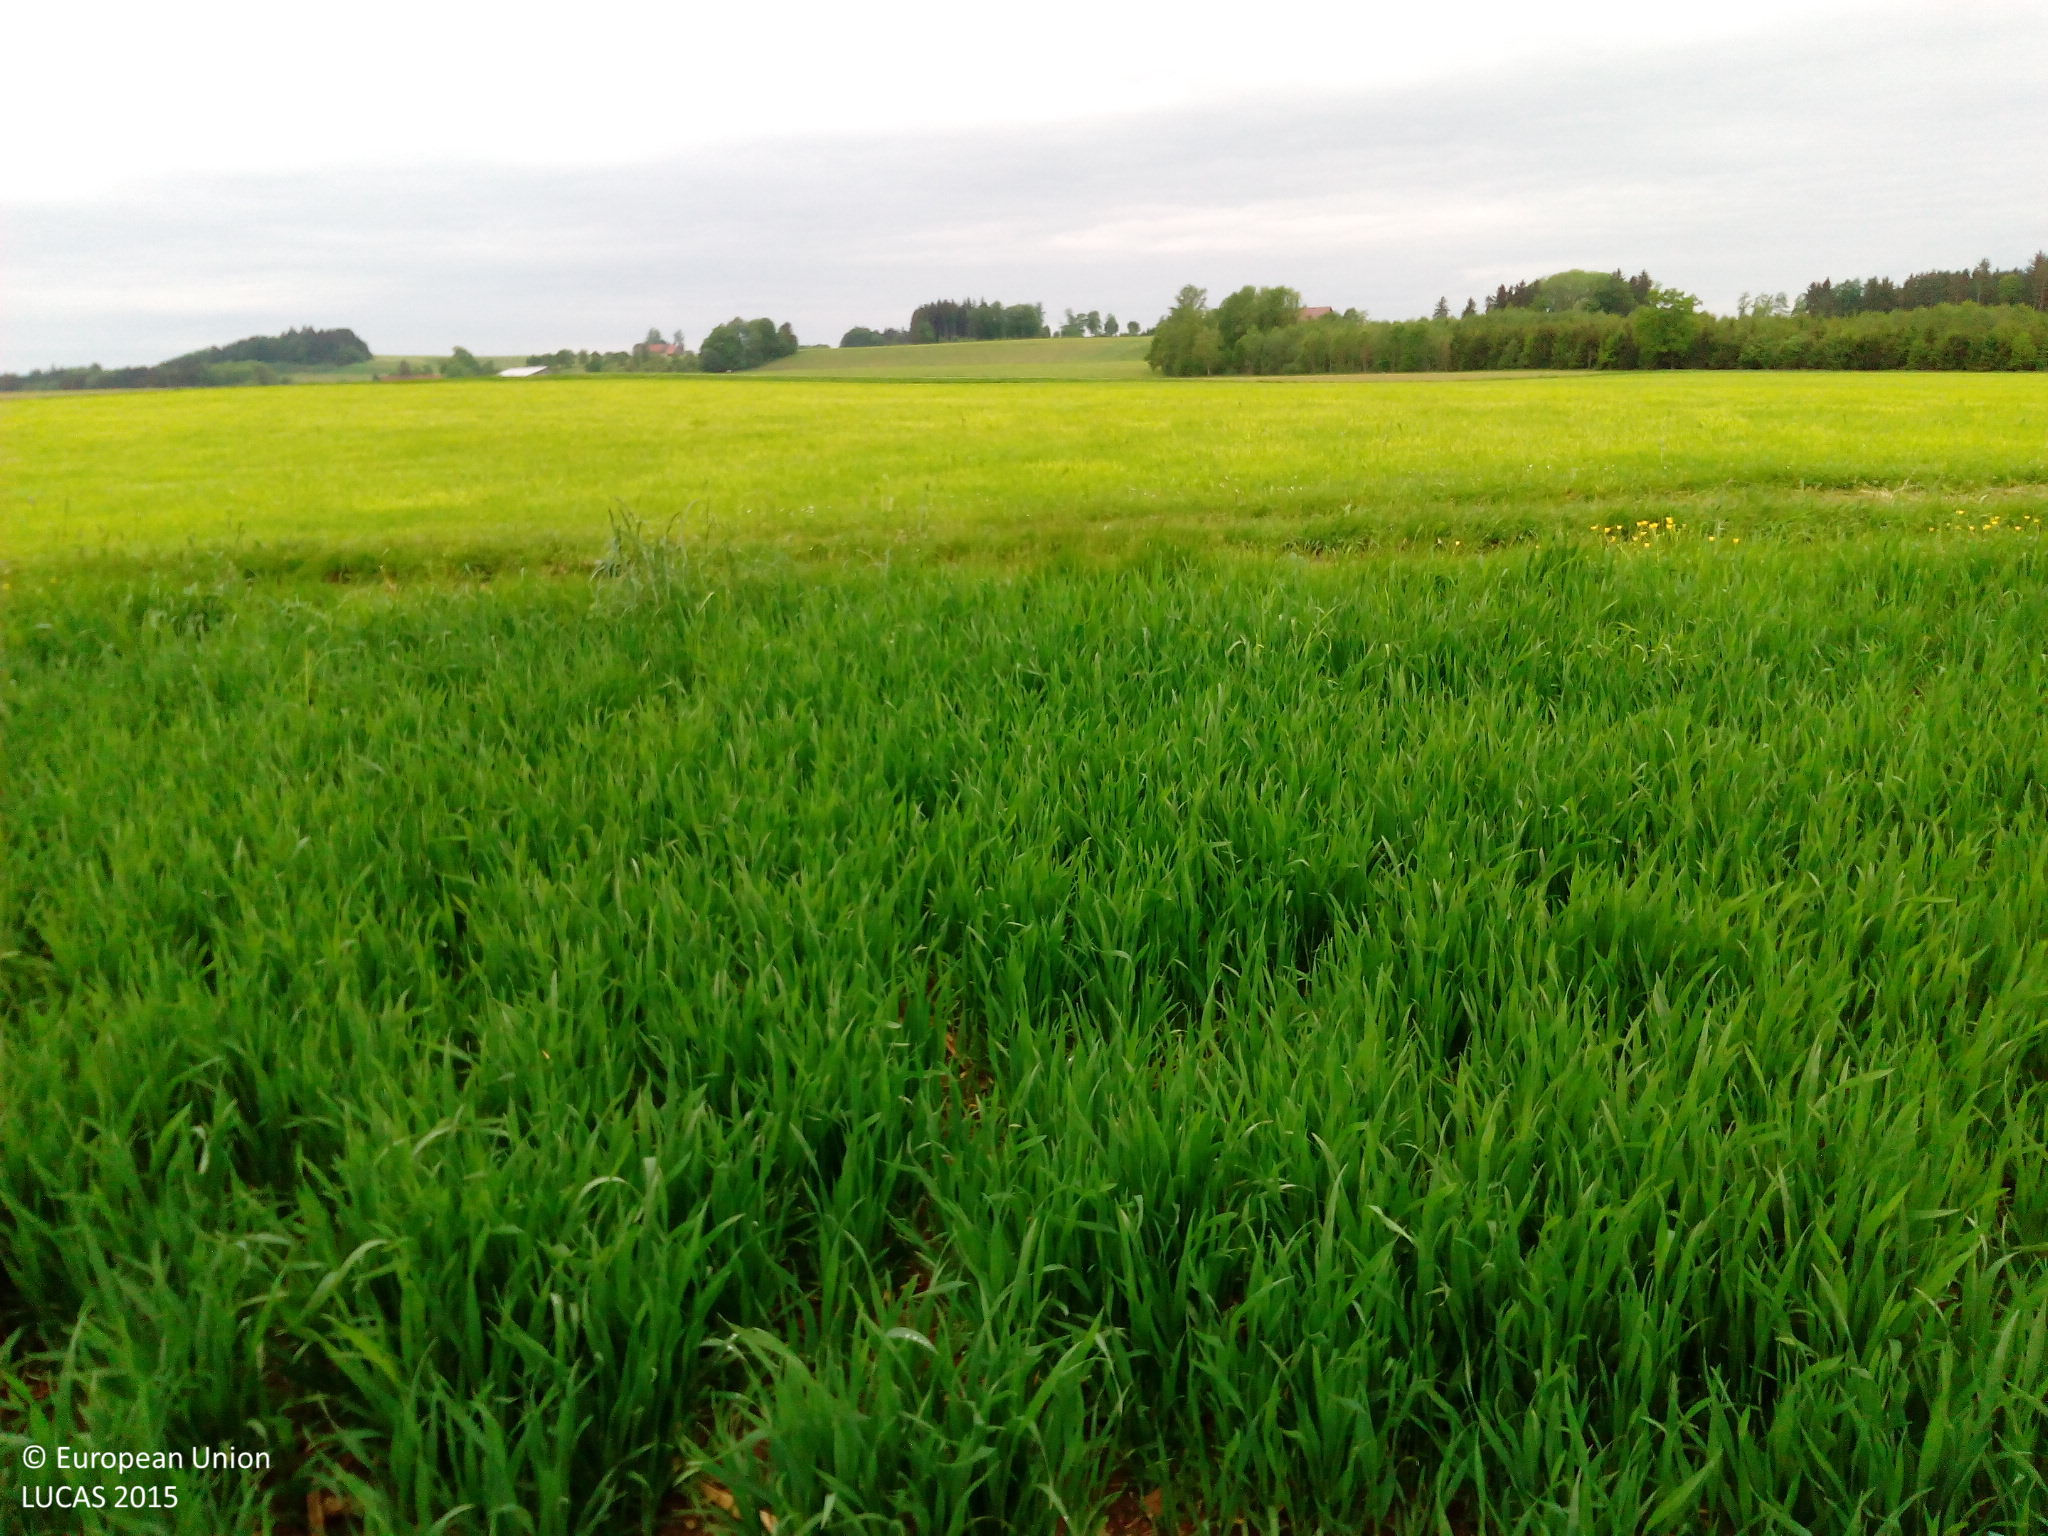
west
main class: Cropland
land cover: Common wheat
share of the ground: > 75 %
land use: Agriculture (excluding fallow land and kitchen gardens)
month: May
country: DE
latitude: 47.9536
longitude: 9.9331
